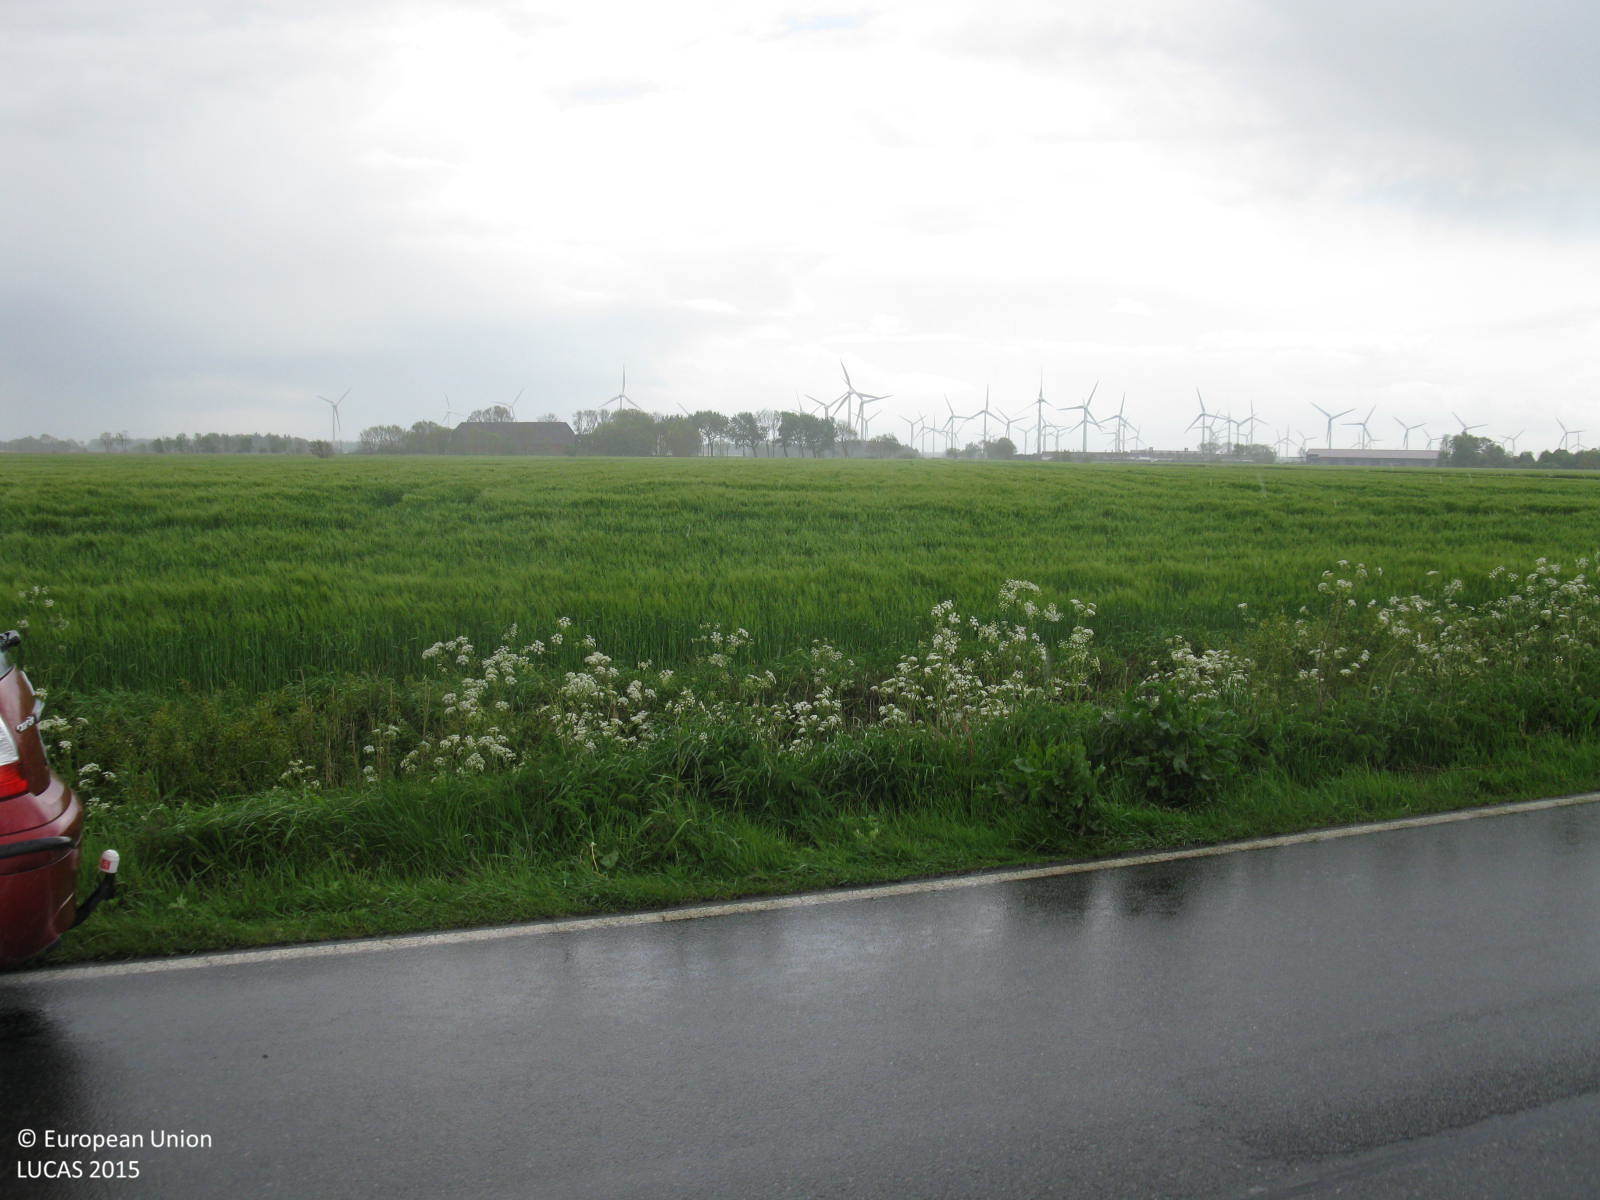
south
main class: Cropland
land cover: Rape and turnip rape
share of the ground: > 75 %
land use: Agriculture (excluding fallow land and kitchen gardens)
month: May
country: DE
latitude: 53.6587
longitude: 7.2618
